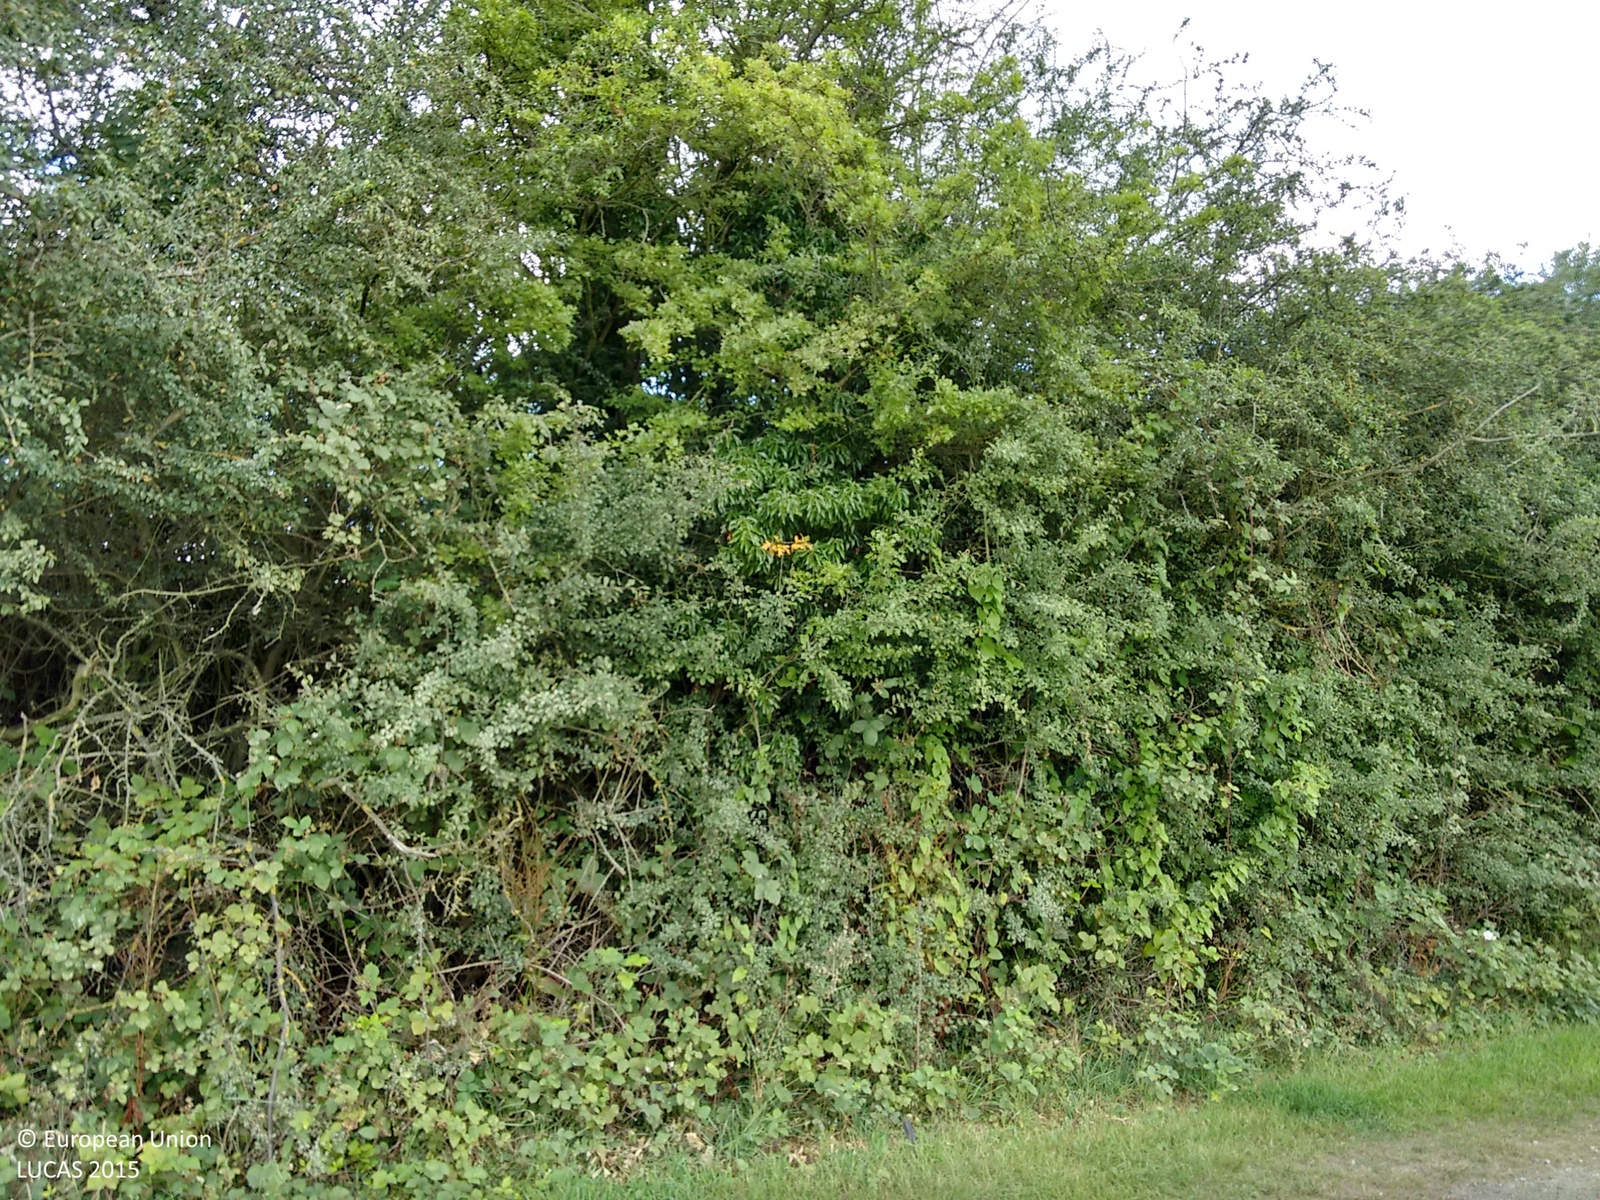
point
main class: Shrubland
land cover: Shrubland with sparse tree cover
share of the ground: > 75 %
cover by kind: shrubs 95 %, broadleaved forest trees 5 %
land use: Agriculture (excluding fallow land and kitchen gardens)
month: July
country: GB
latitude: 51.5510
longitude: -0.4648
